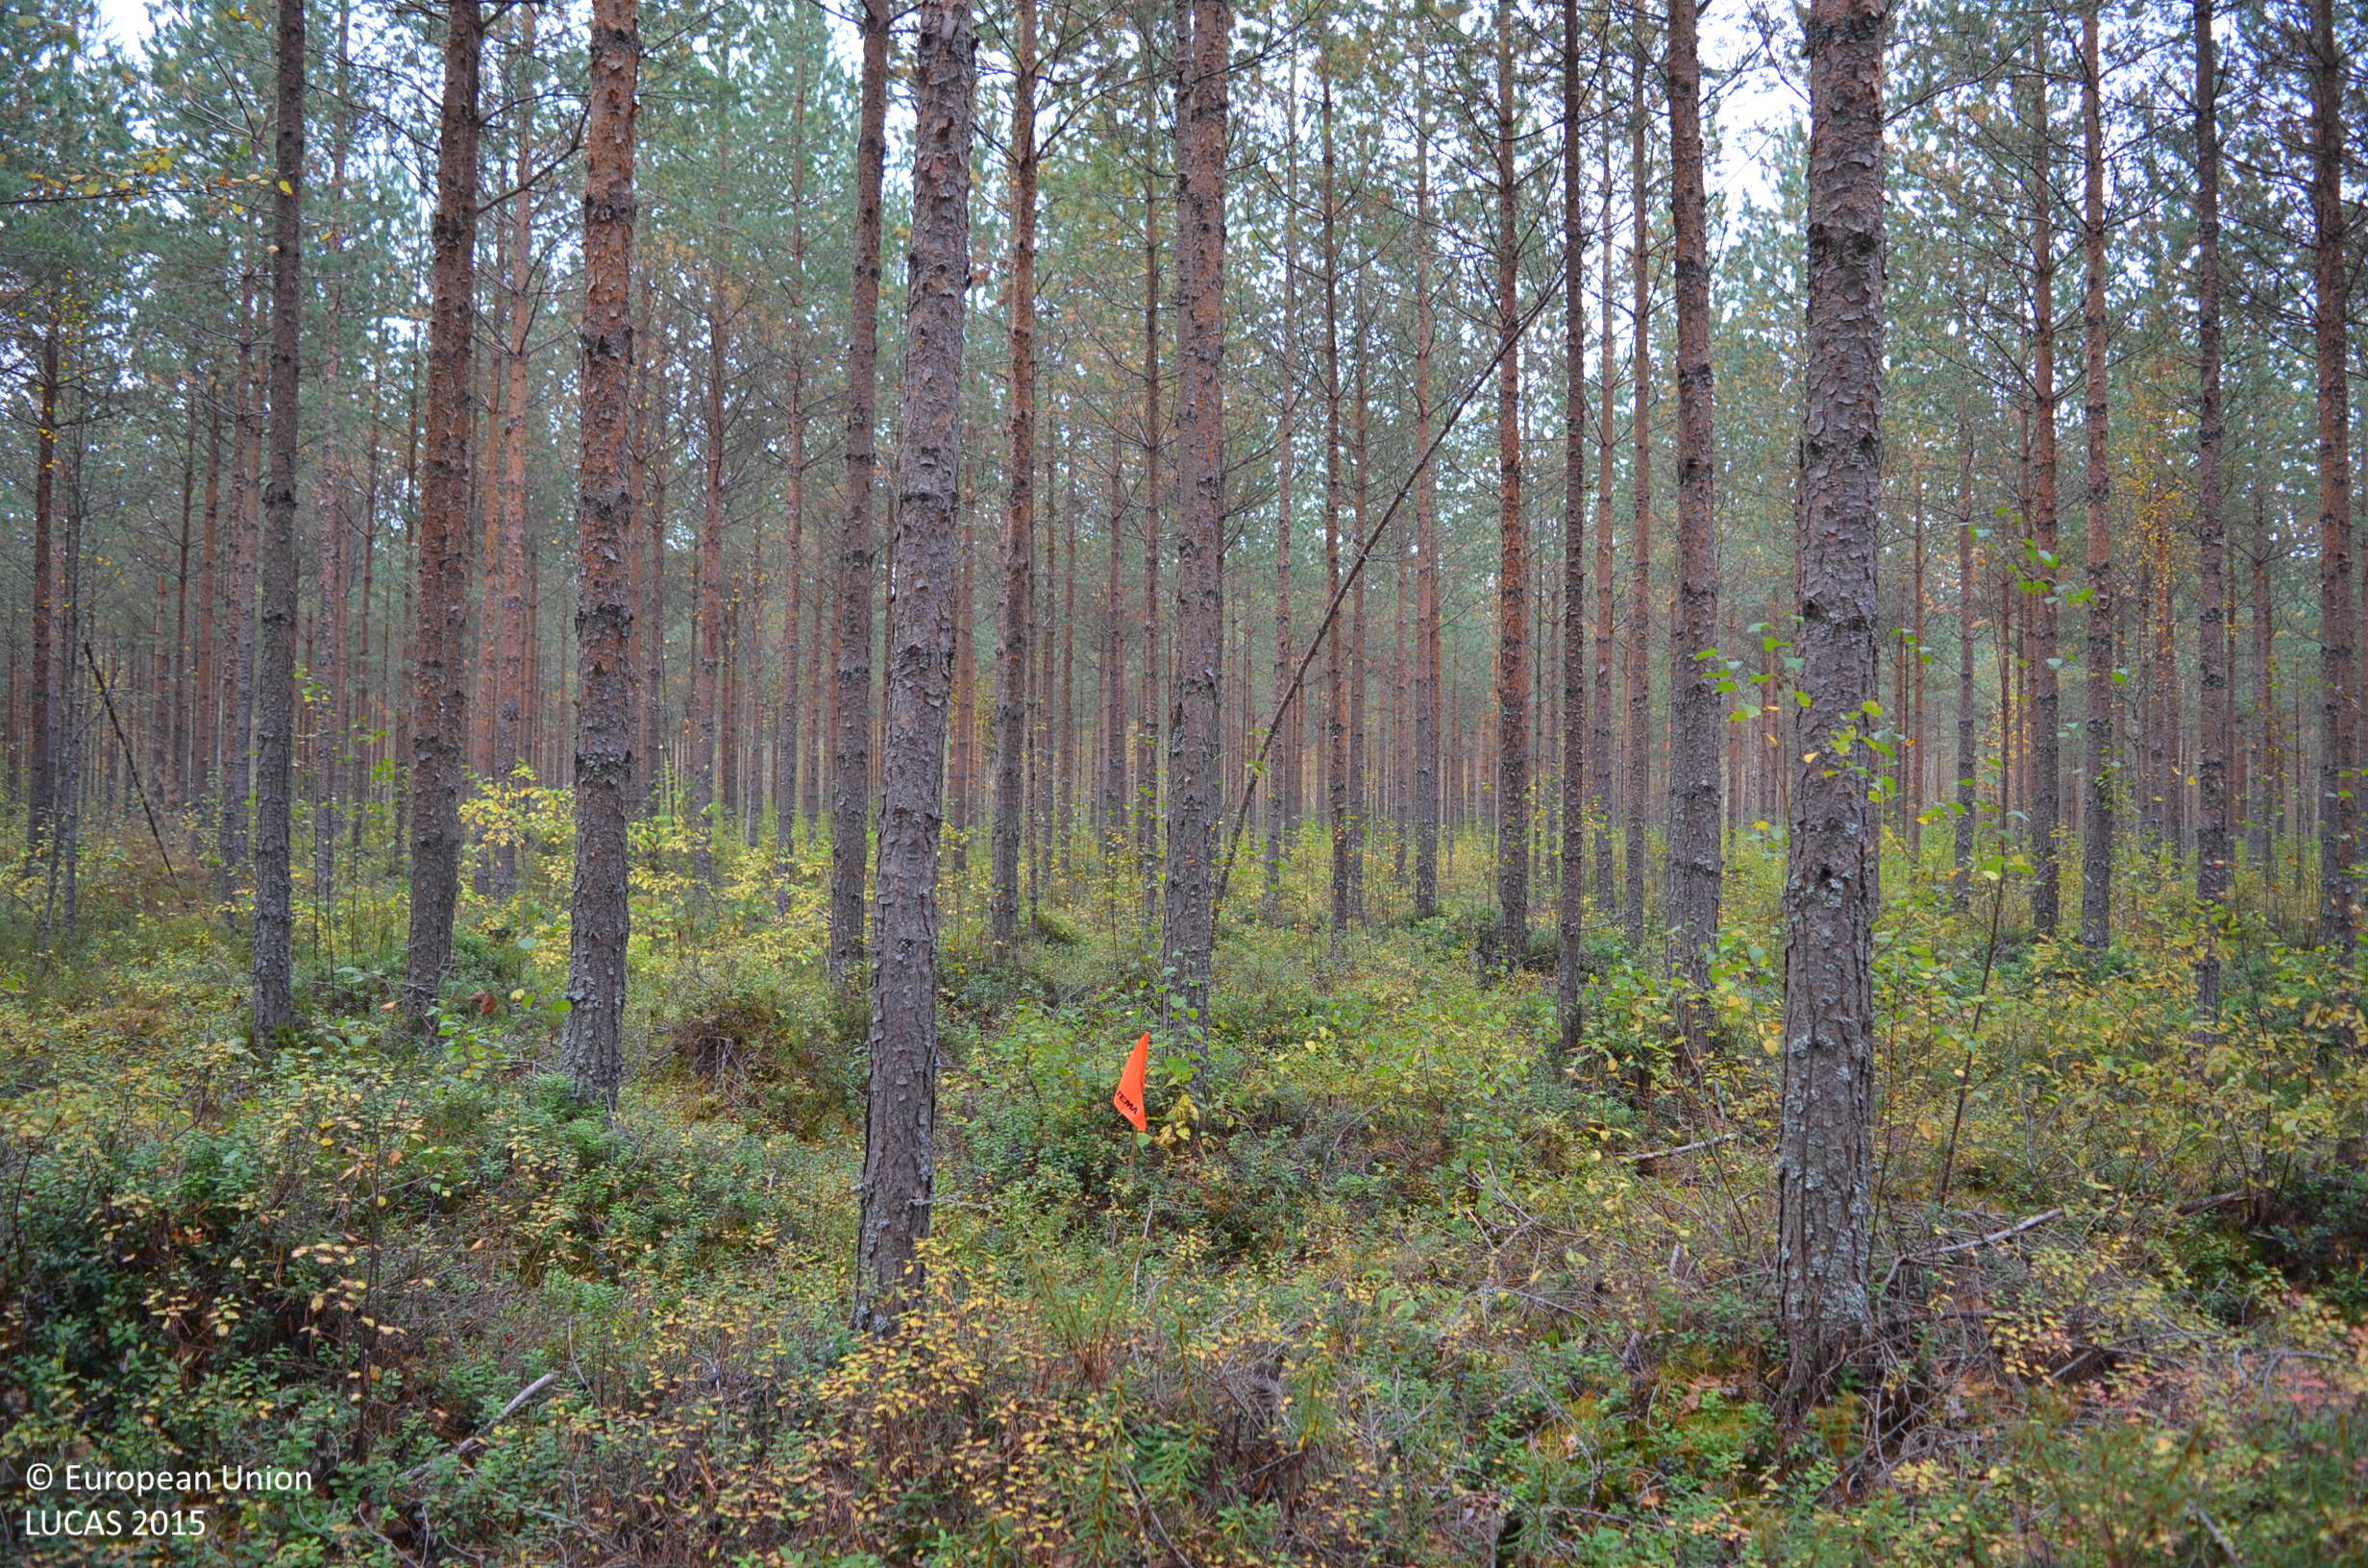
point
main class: Woodland
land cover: Pine dominated coniferous woodland
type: boreal forest
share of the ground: > 75 %
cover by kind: coniferous forest trees 75 %, shrubs 20 %, broadleaved forest trees 5 %
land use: Forestry
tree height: > 5 m
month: September
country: FI
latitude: 62.8466
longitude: 23.8821
